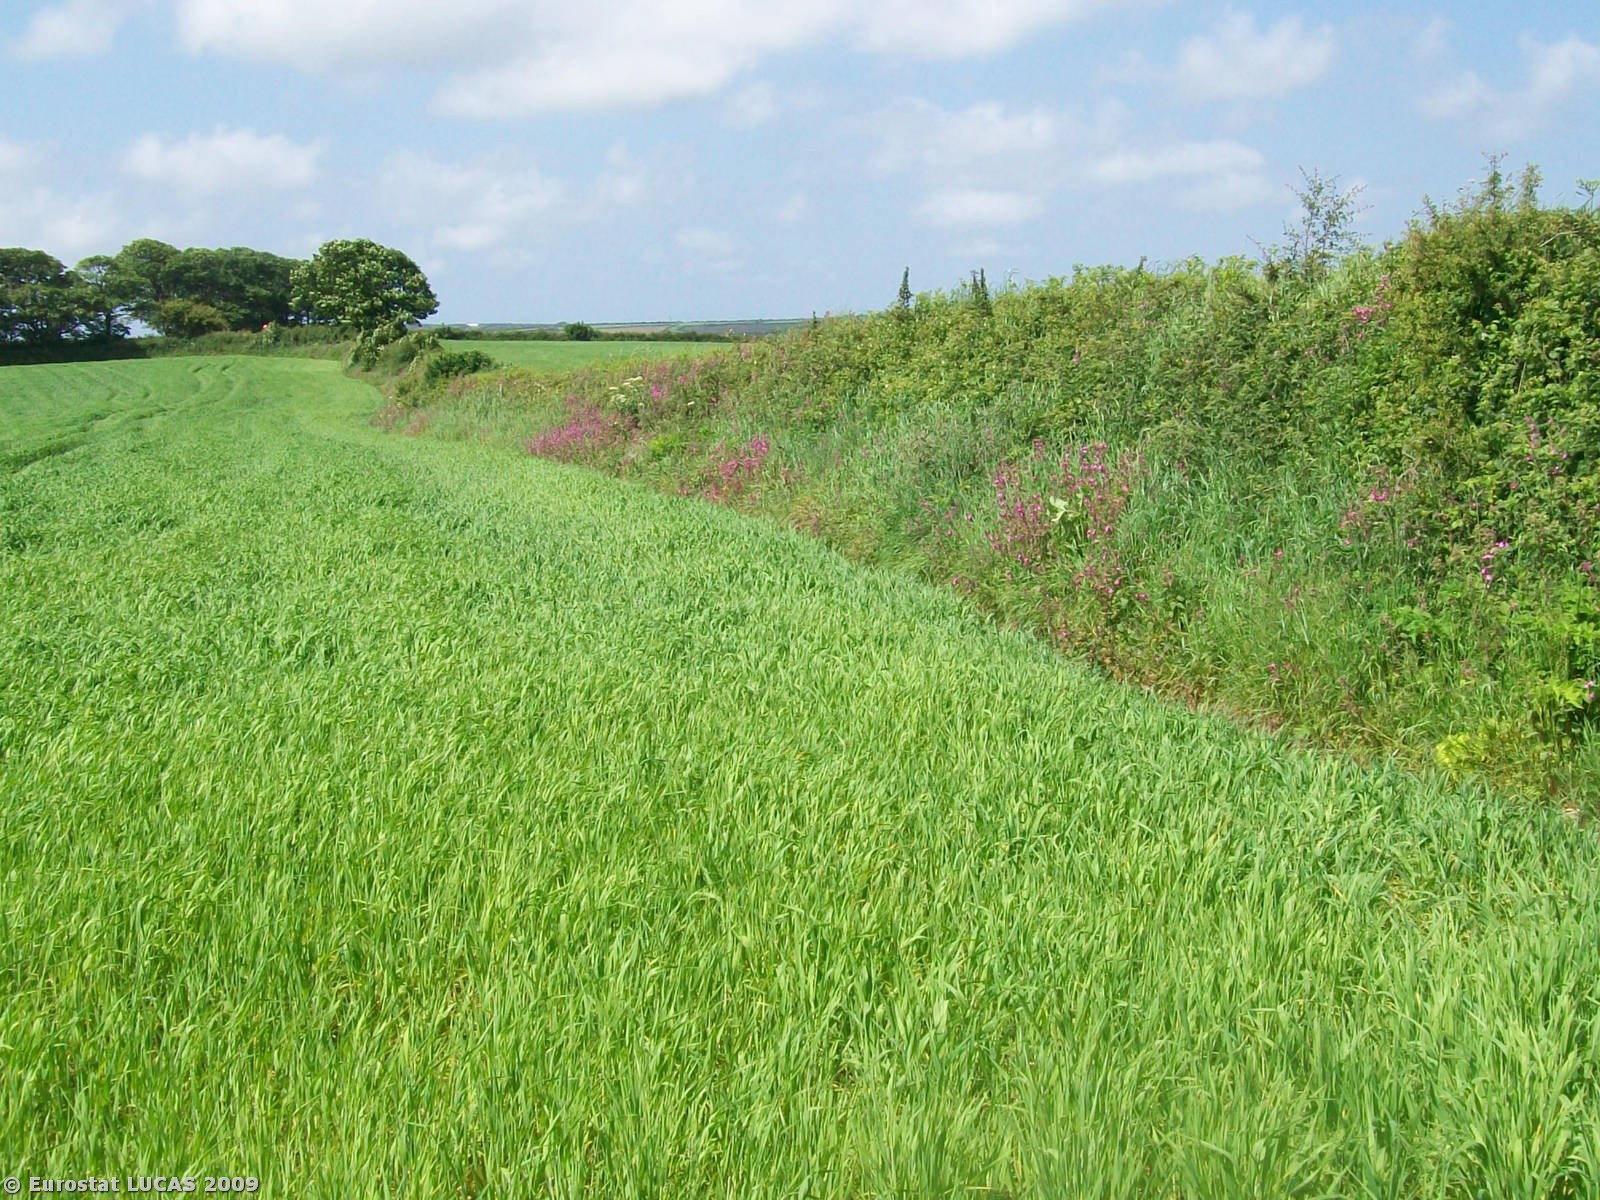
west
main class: Cropland
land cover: Temporary grasslands
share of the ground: > 75 %
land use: Agriculture (excluding fallow land and kitchen gardens)
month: June
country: GB
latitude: 50.1154
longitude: -5.1525
